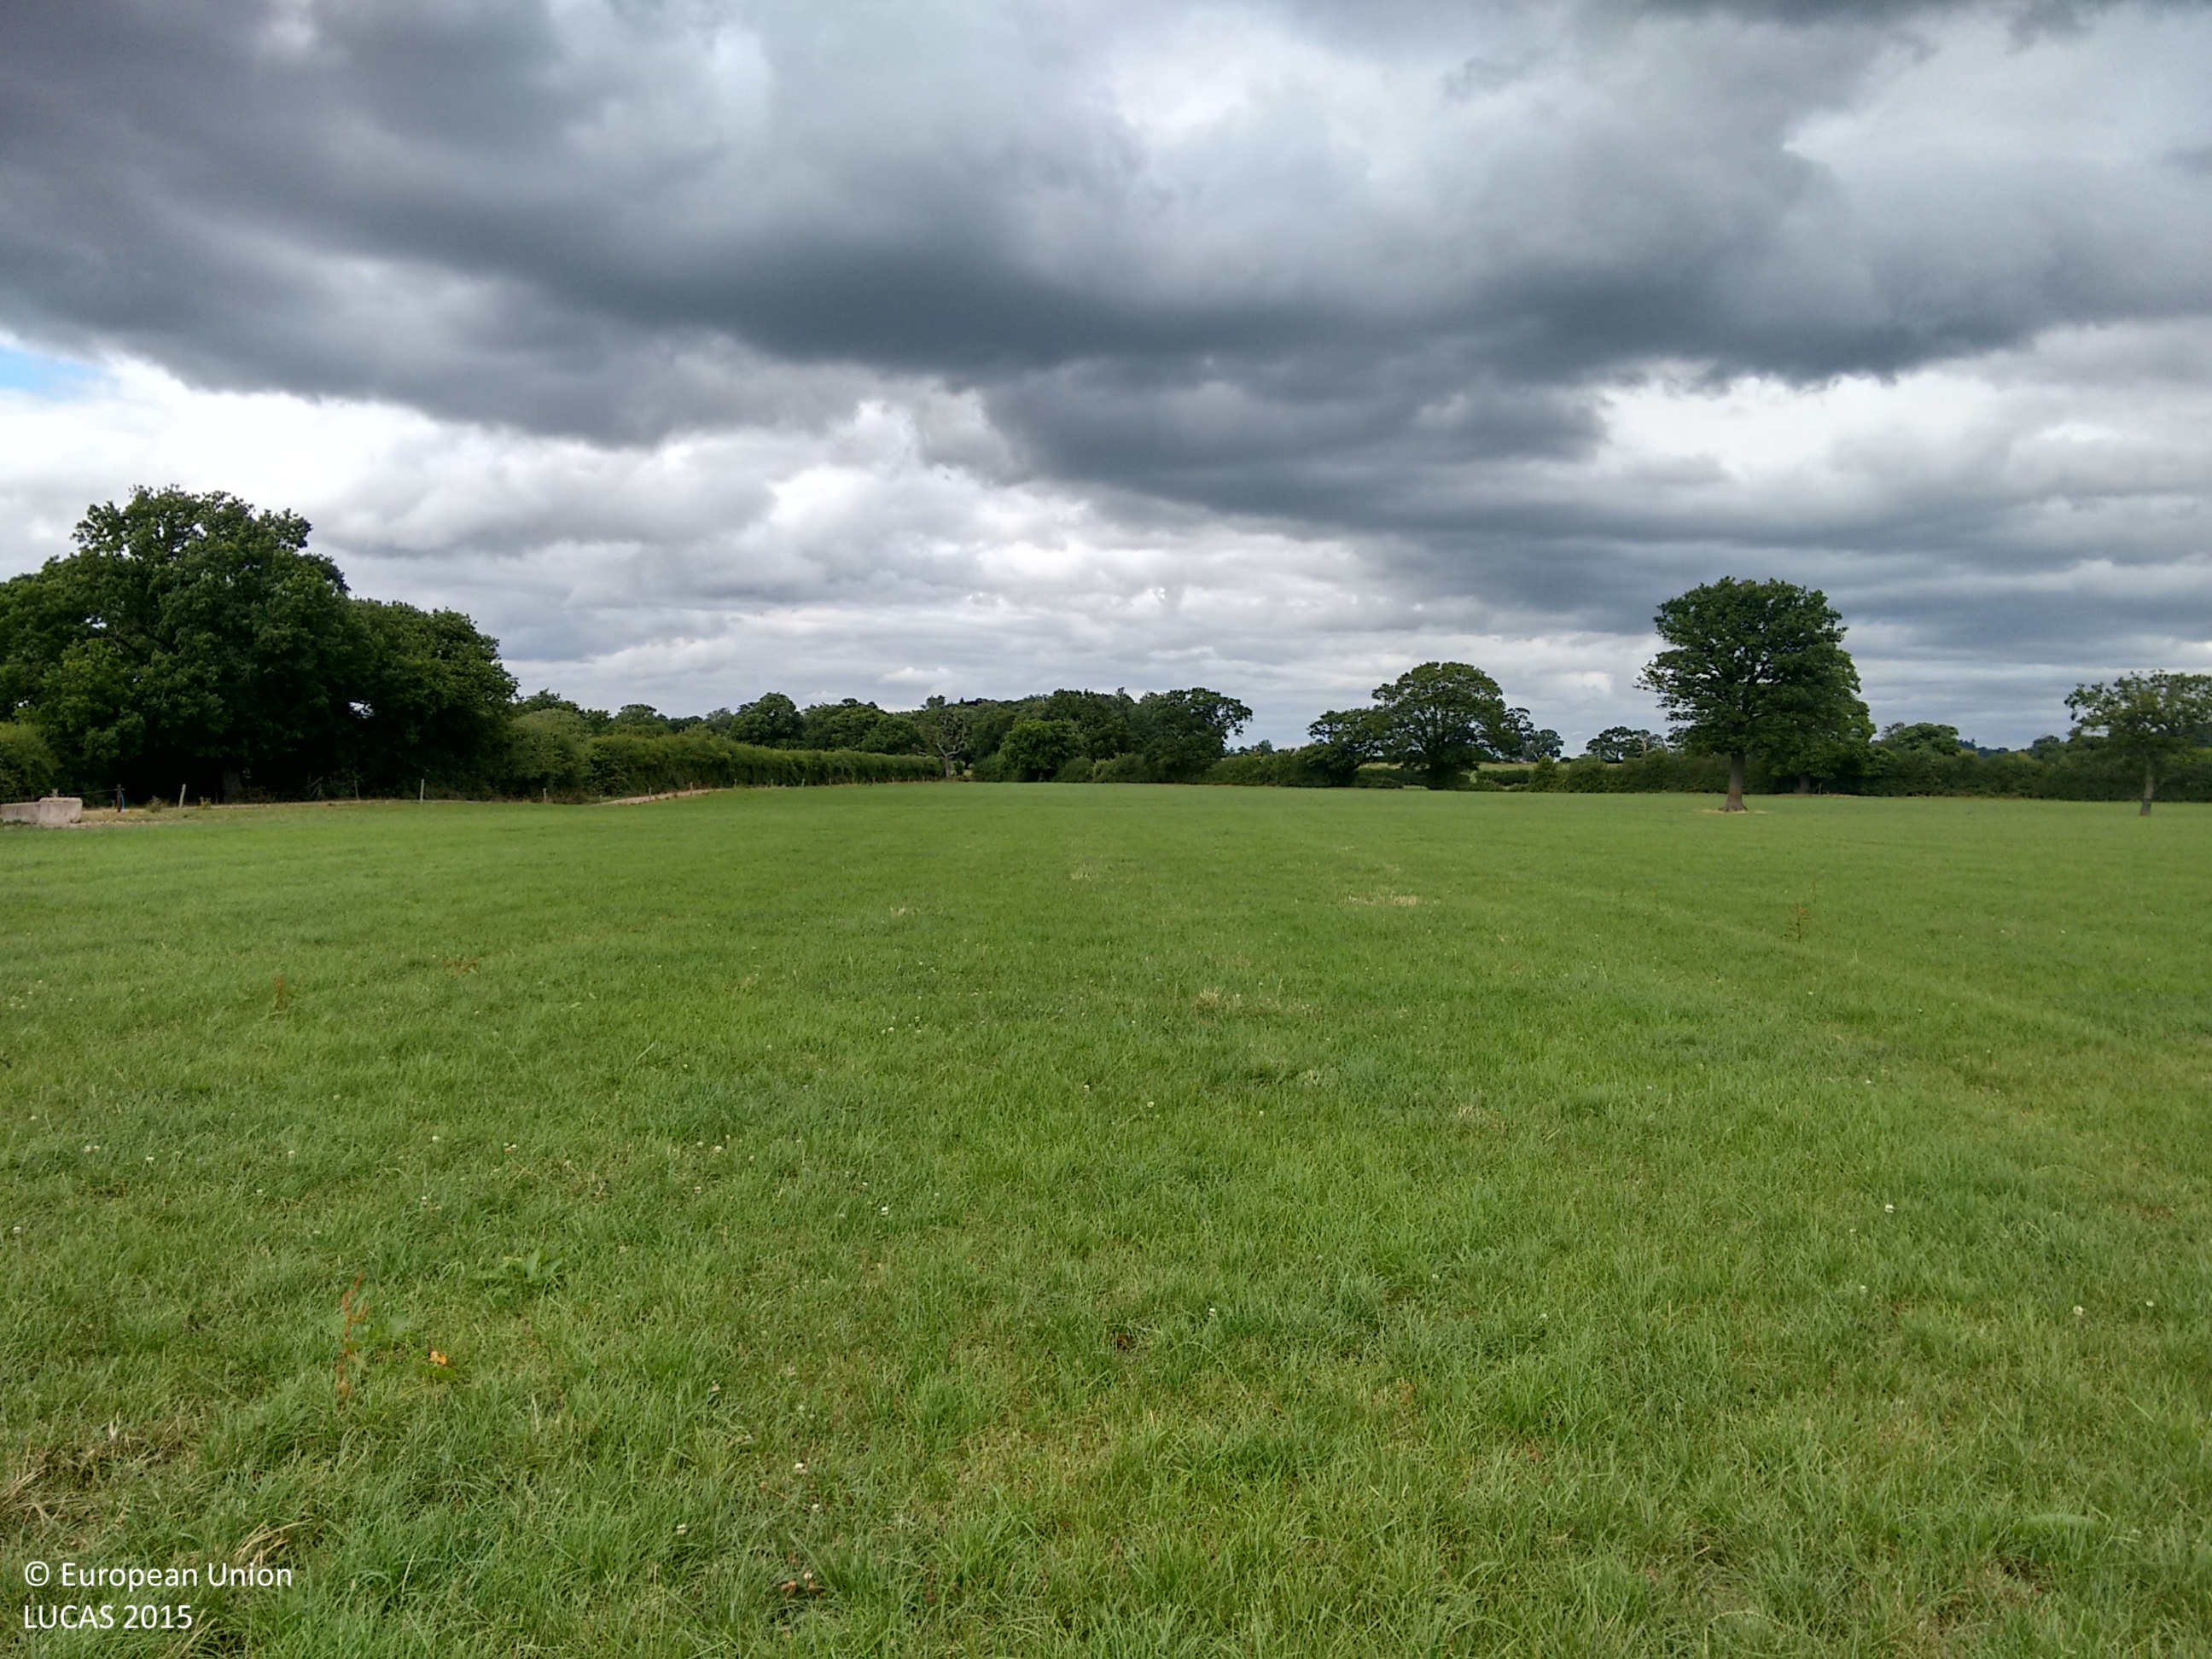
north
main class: Grassland
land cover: Grassland without tree/shrub cover
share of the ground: > 75 %
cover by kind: herbaceous plants 100 %
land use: Agriculture (excluding fallow land and kitchen gardens)
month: July
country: GB
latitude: 53.0619
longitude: -2.8299
